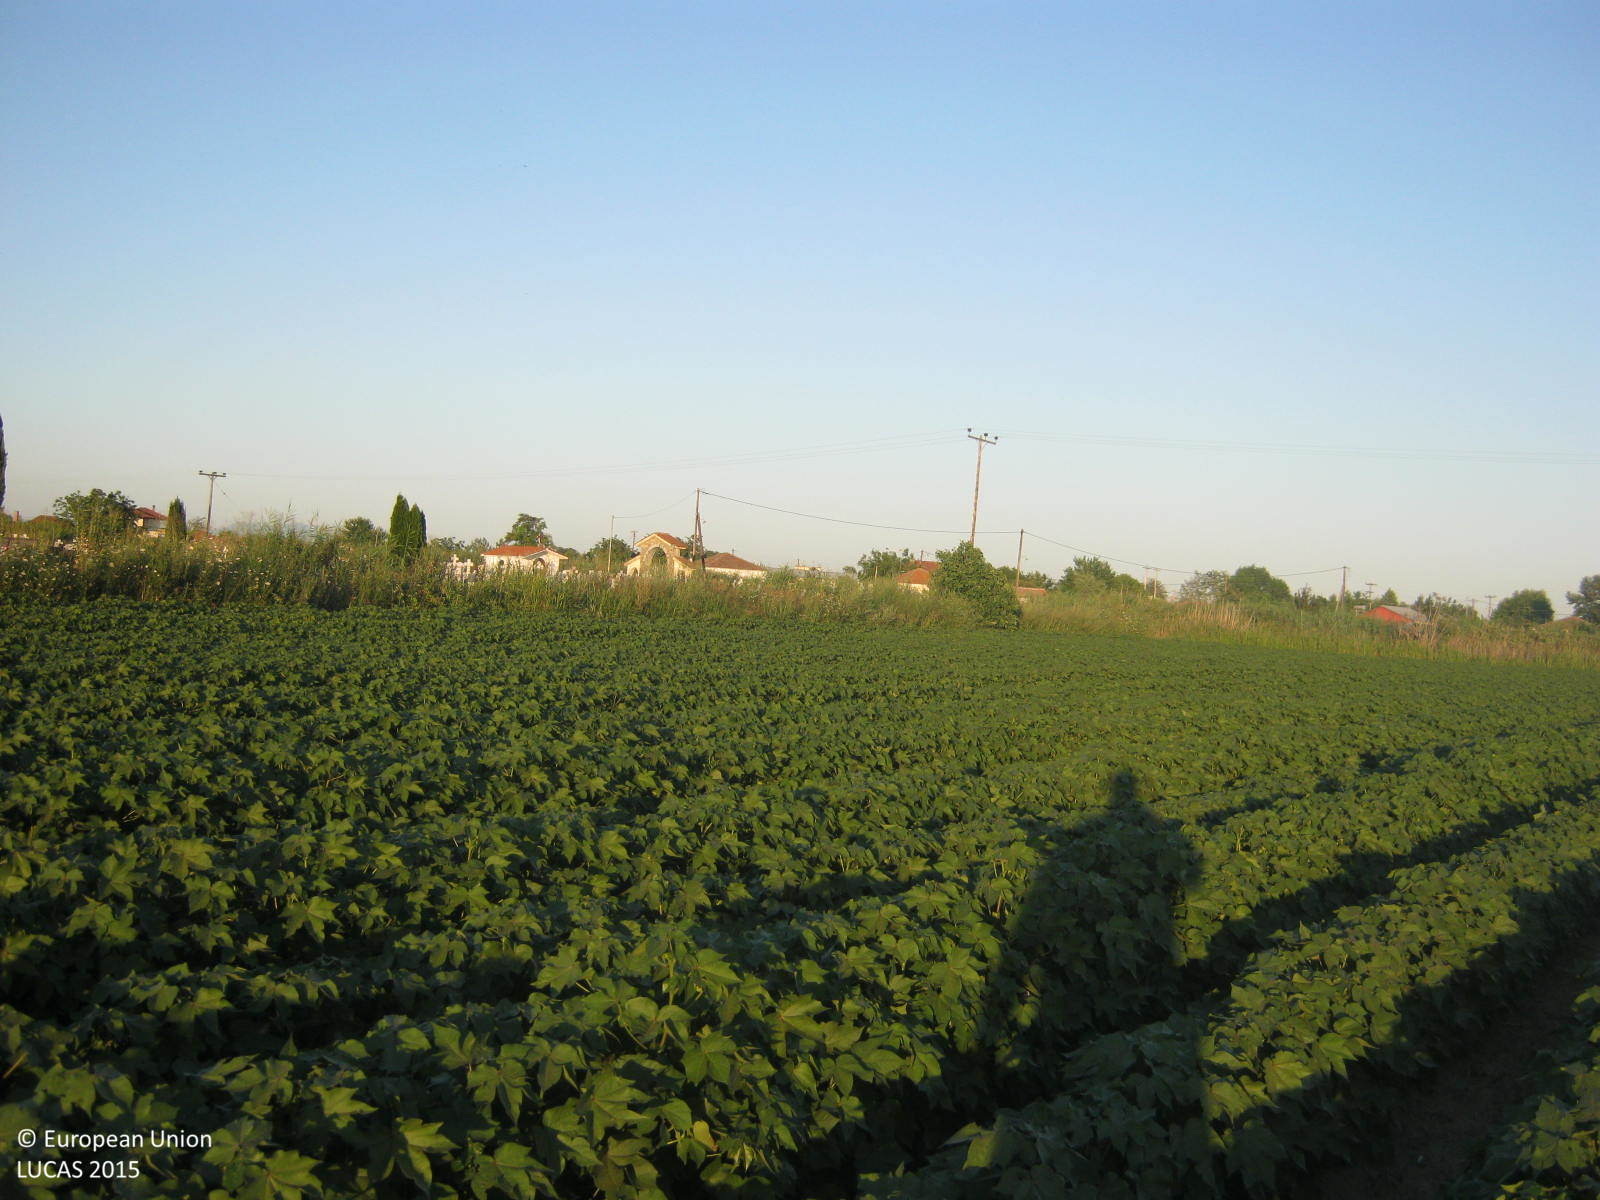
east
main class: Cropland
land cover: Cotton
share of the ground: > 75 %
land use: Agriculture (excluding fallow land and kitchen gardens)
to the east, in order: Cotton; Shruby margins; Artificial constructions in urban areas; Inland marshes; Grass margins; Paved roads, cycling and walking lanes; Grass margins; Fences; Spontaneously vegetated surfaces; Cotton
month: July
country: GR
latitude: 40.5691
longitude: 22.5820
